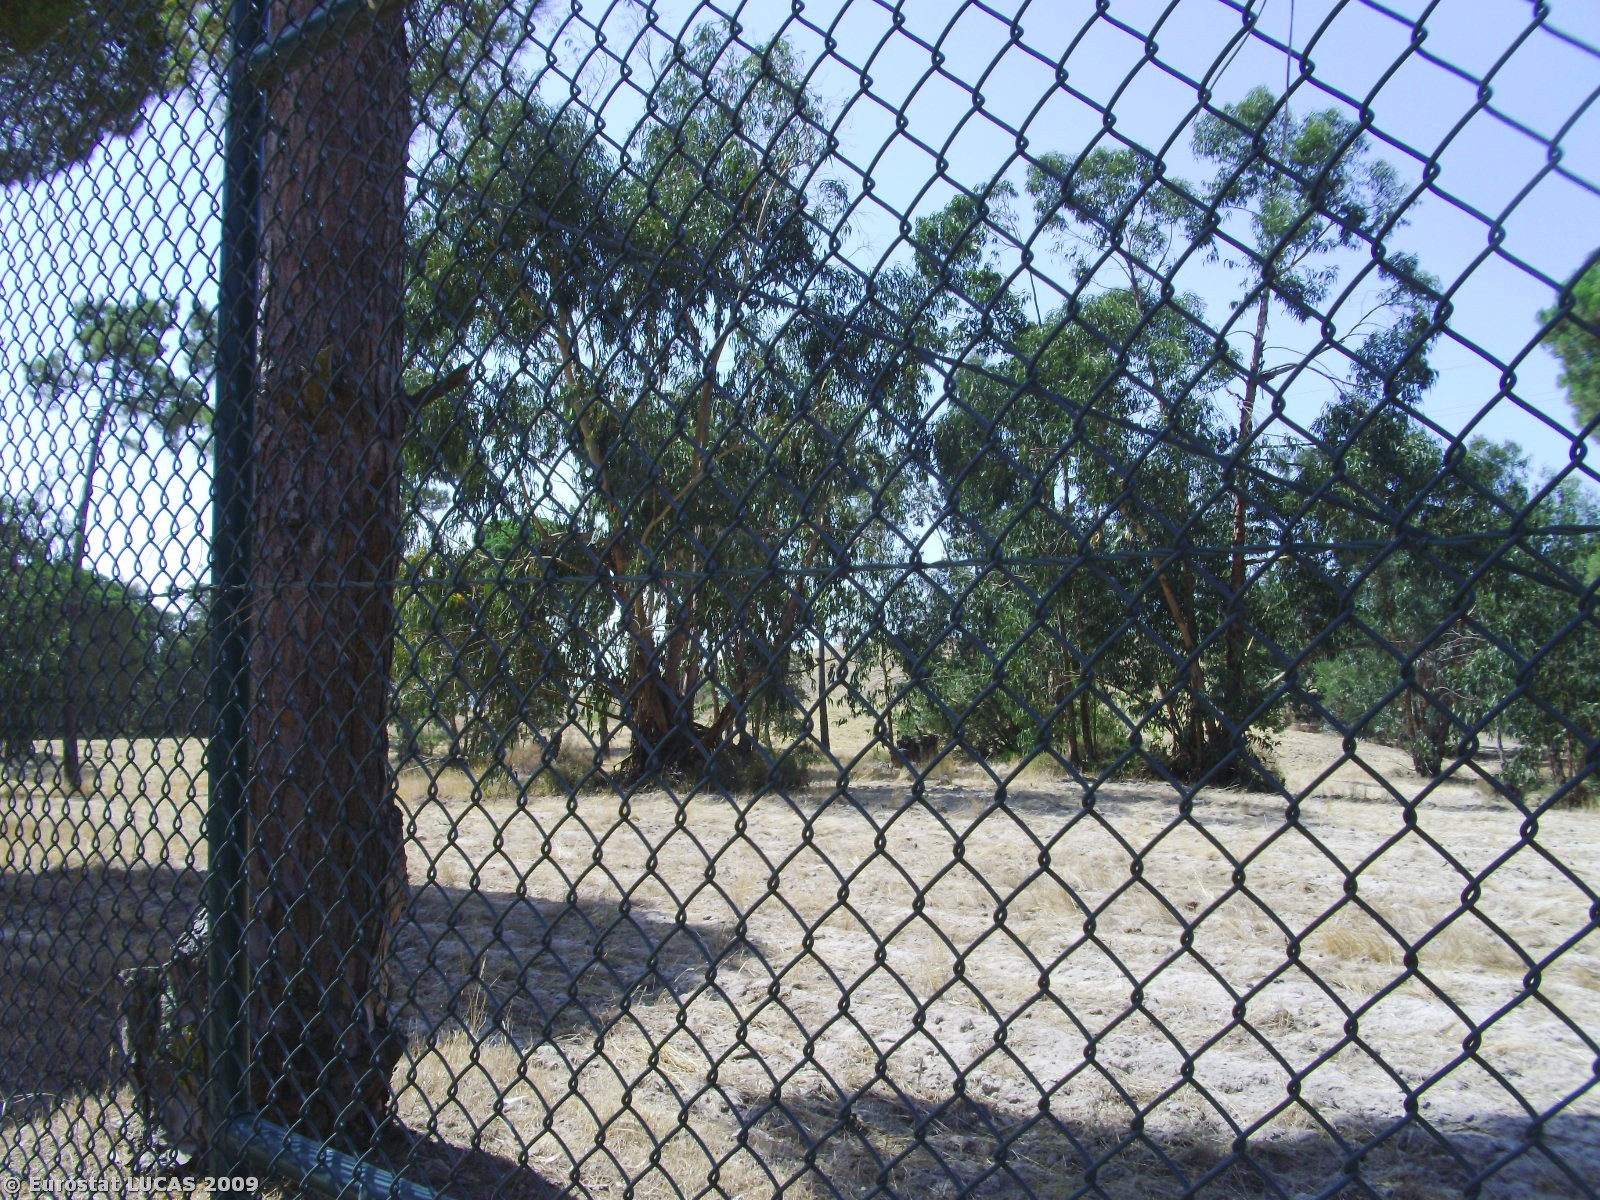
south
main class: Woodland
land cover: Broadleaved woodland
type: plantations and self-sown exotic forest
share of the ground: 25 - 50 %
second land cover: Bare land
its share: 50 - 75 %
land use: Forestry
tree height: > 5 m
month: July
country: PT
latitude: 38.5034
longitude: -8.8099
